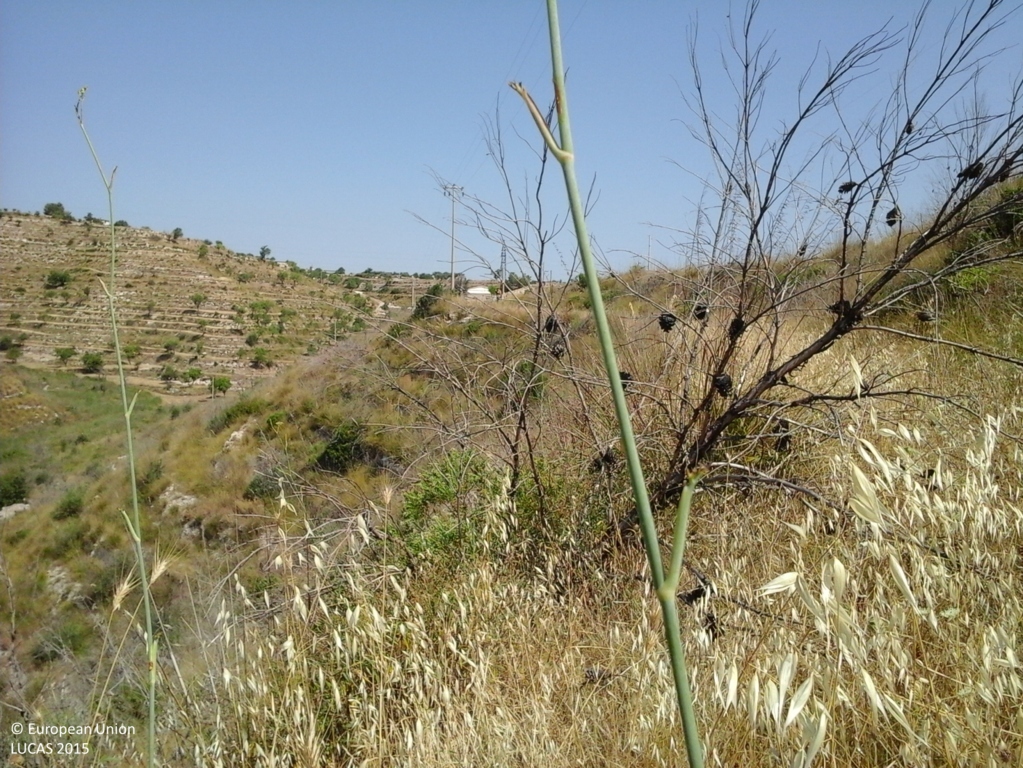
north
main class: Shrubland
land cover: Shrubland without tree cover
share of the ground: > 75 %
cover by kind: herbaceous plants 60 %, shrubs 40 %
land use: Fallow land
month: July
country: IT
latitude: 37.0053
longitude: 14.8506
